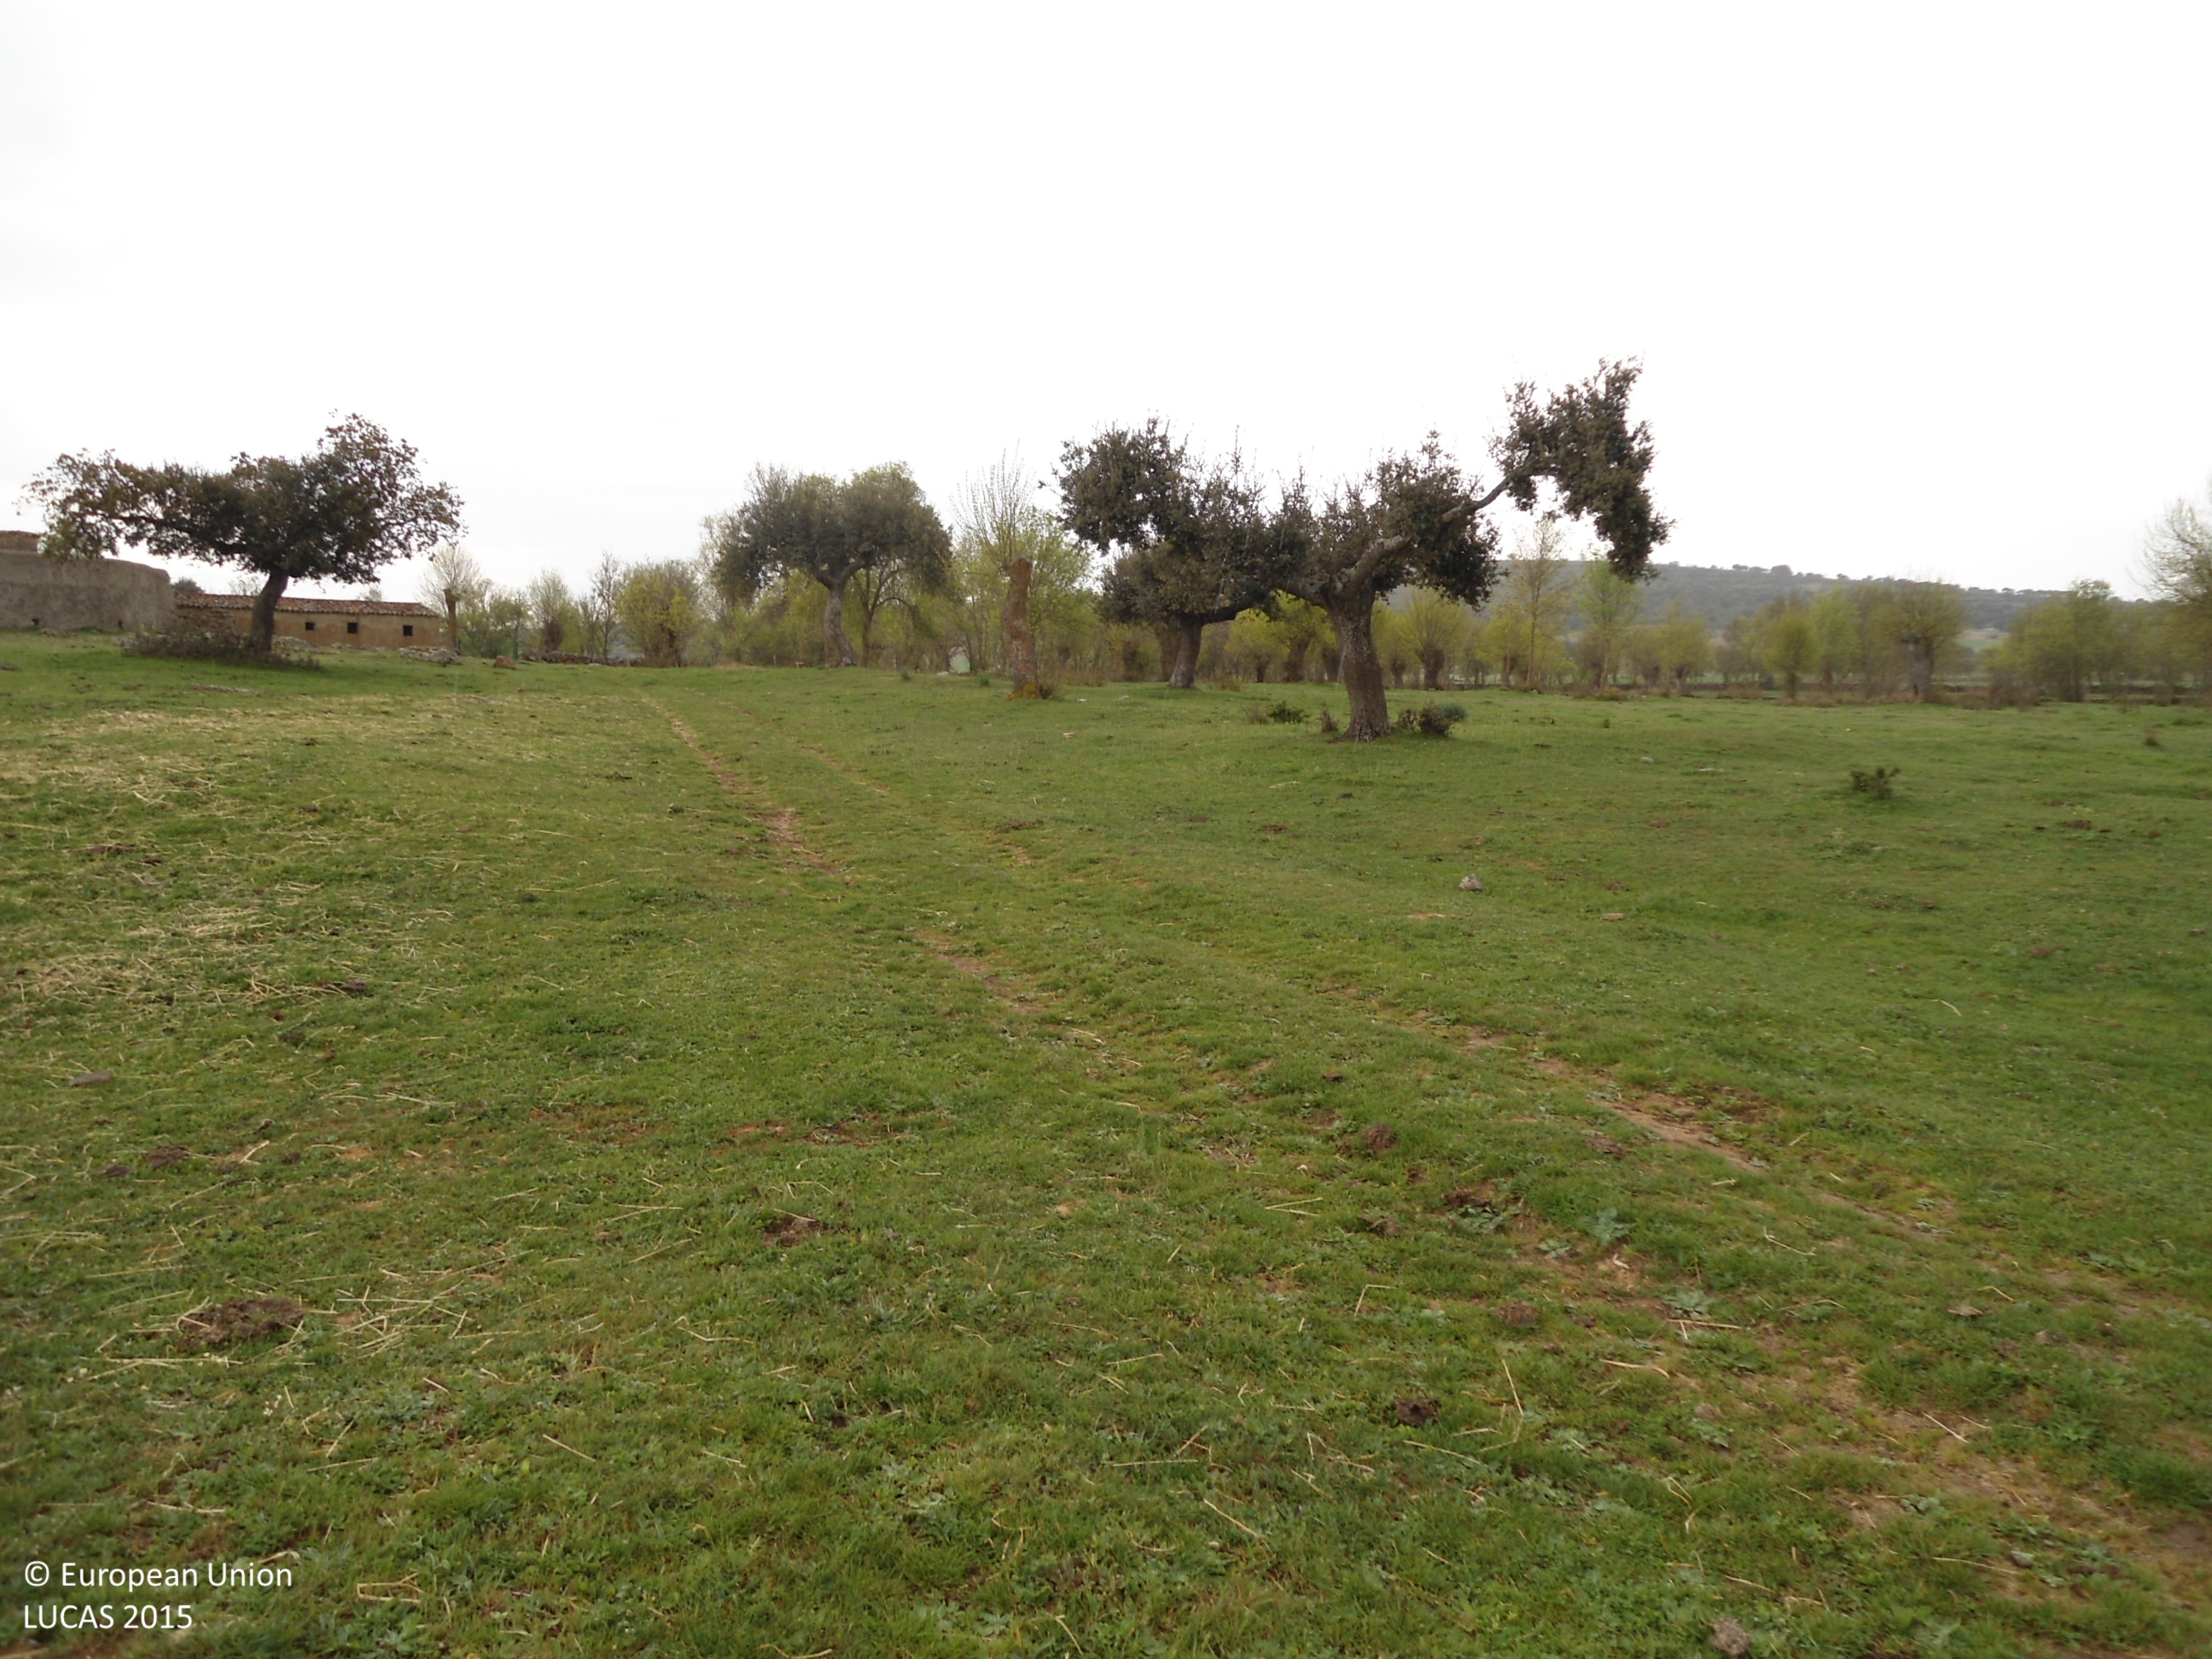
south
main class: Grassland
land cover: Grassland without tree/shrub cover
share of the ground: > 75 %
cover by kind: herbaceous plants 100 %
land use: Agriculture (excluding fallow land and kitchen gardens)
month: April
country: ES
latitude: 41.7510
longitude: -5.9320
